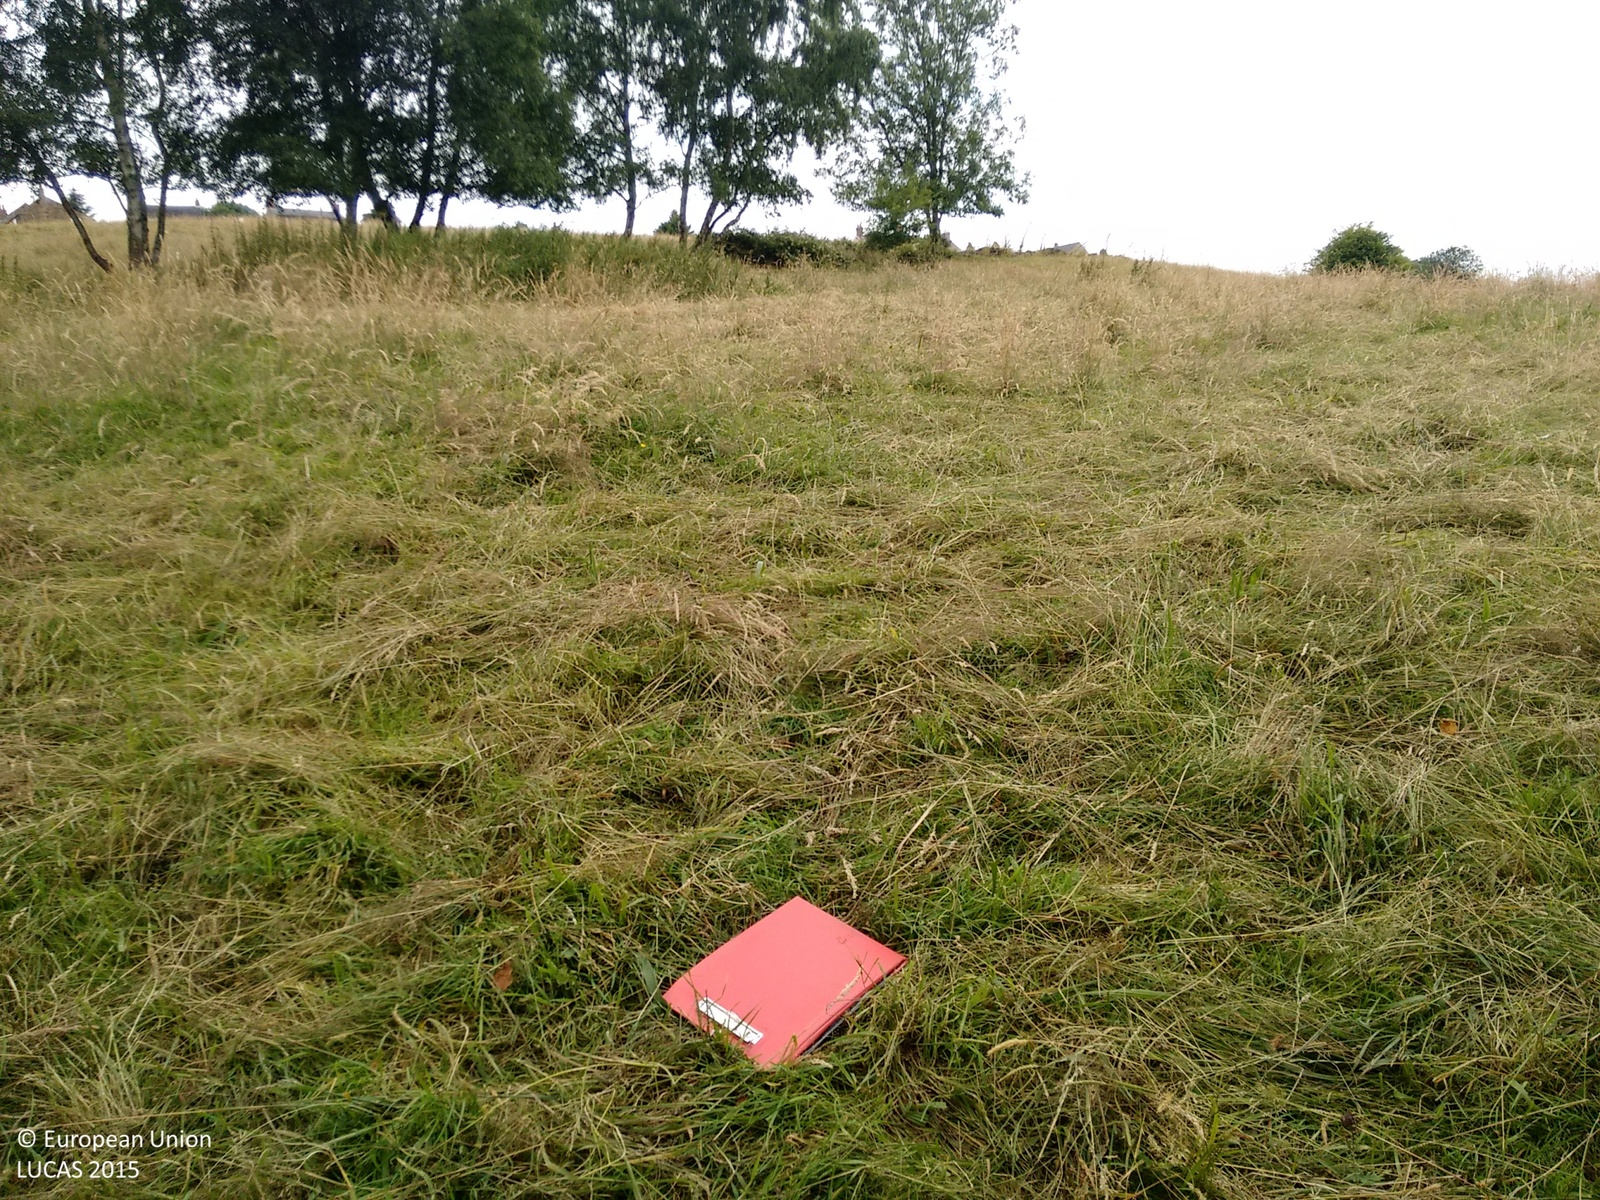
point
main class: Grassland
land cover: Grassland without tree/shrub cover
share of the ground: > 75 %
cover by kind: herbaceous plants 100 %
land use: Agriculture (excluding fallow land and kitchen gardens)
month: July
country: GB
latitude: 53.0730
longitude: -1.4683
